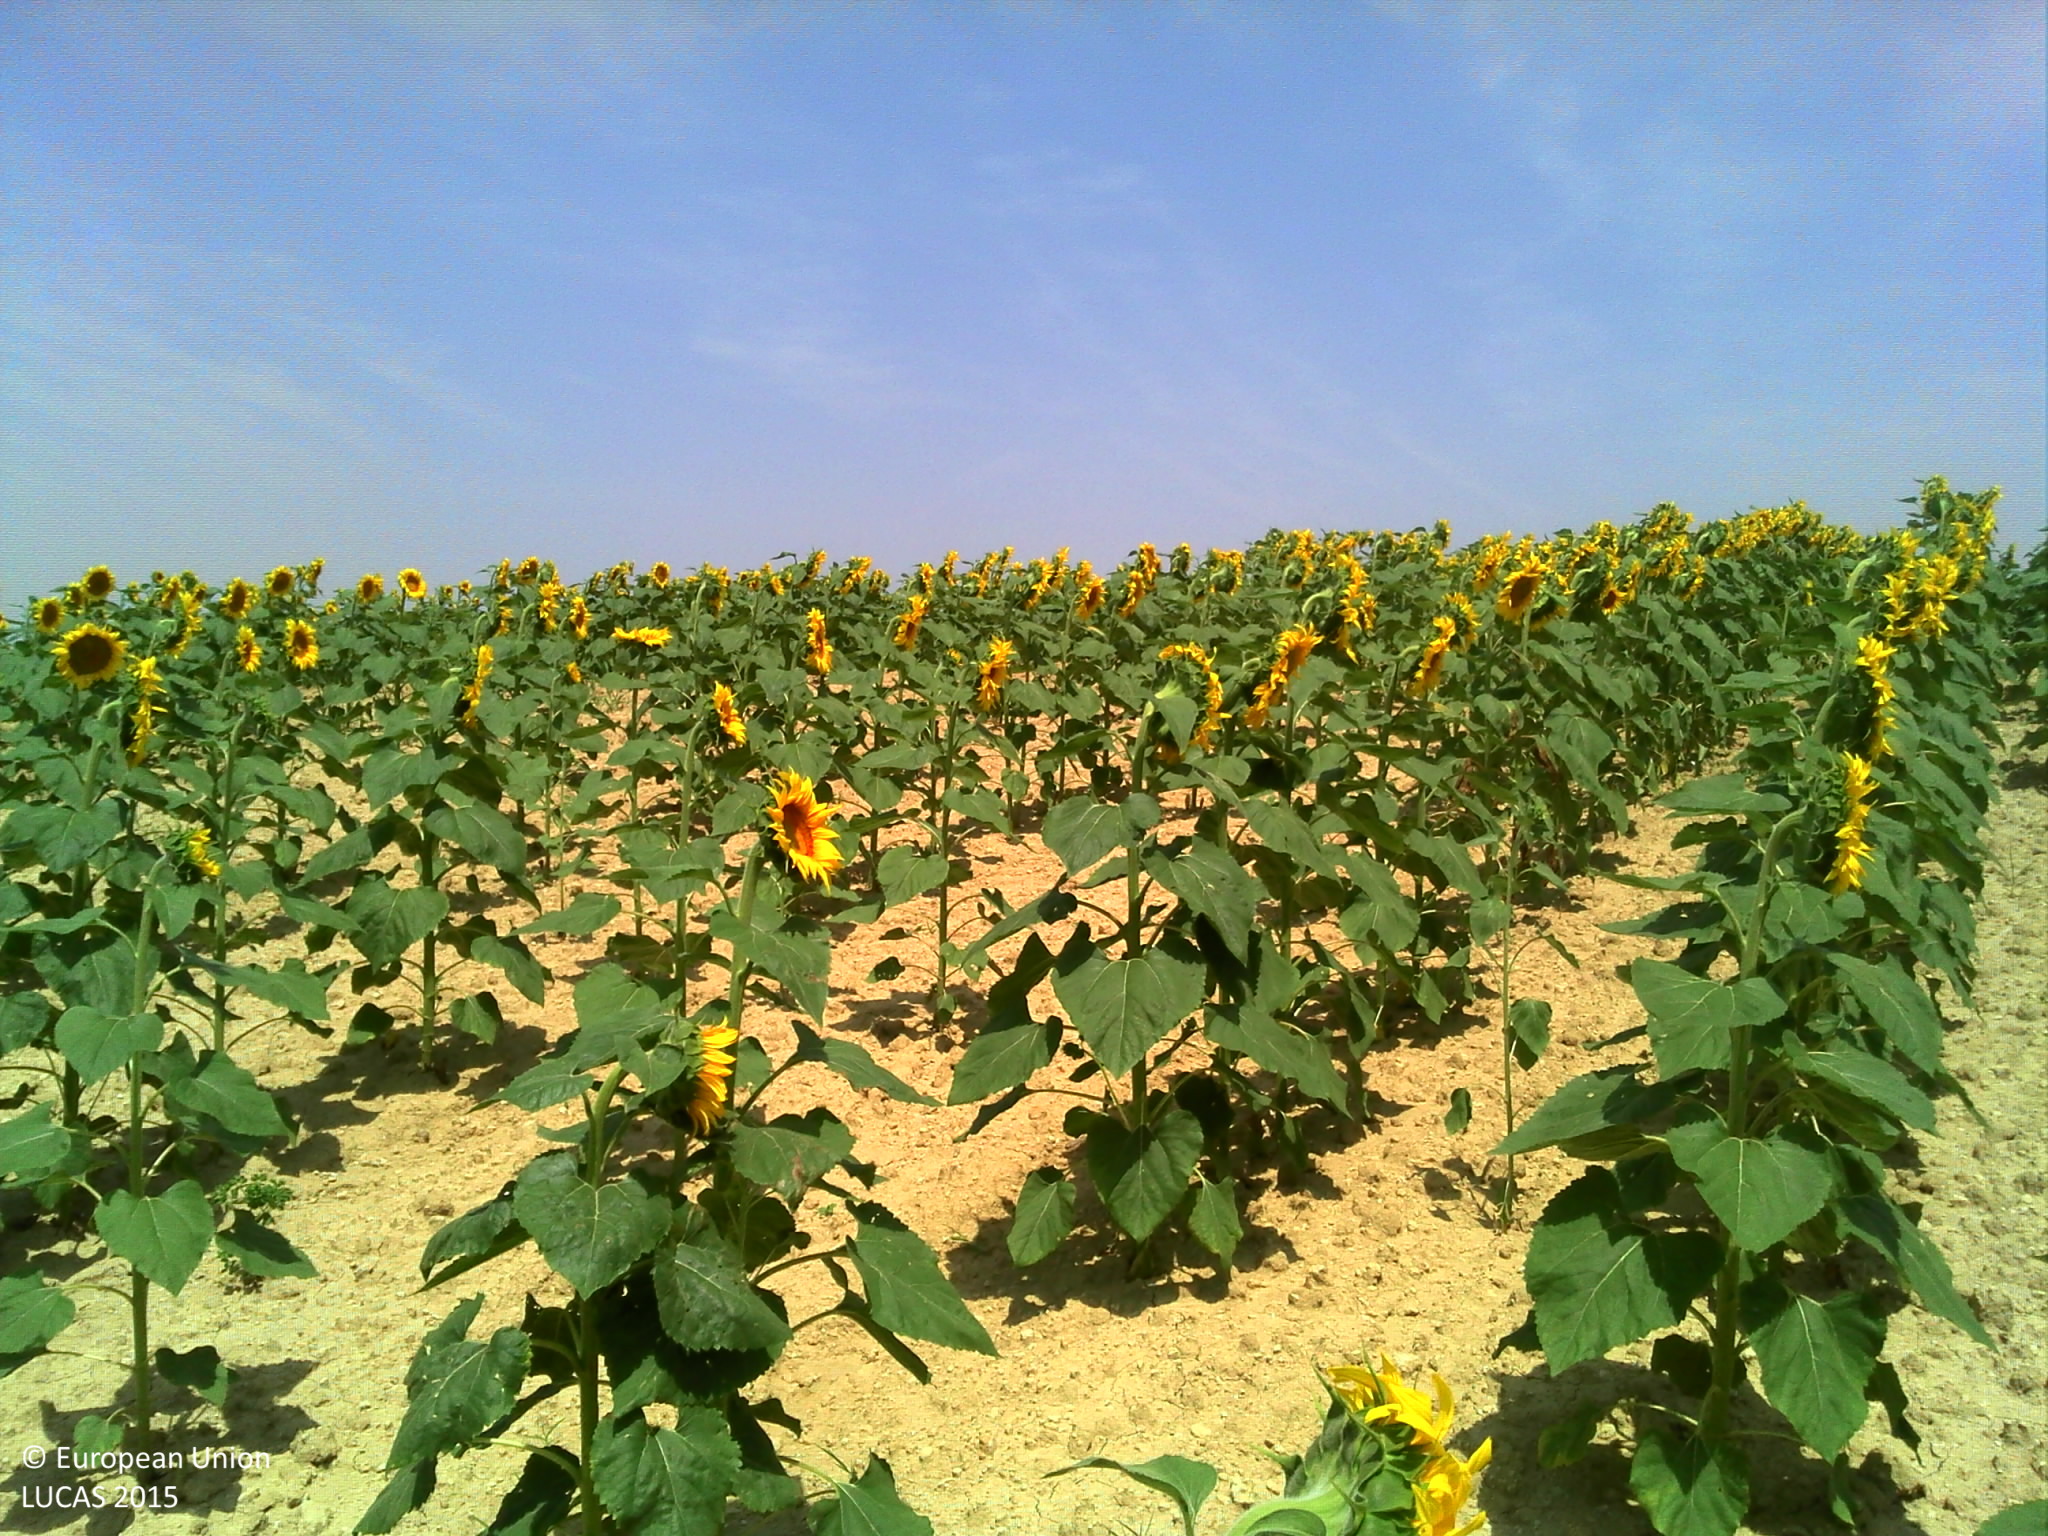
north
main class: Cropland
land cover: Sunflower
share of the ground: > 75 %
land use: Agriculture (excluding fallow land and kitchen gardens)
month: July
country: FR
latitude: 43.6893
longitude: 1.0303
